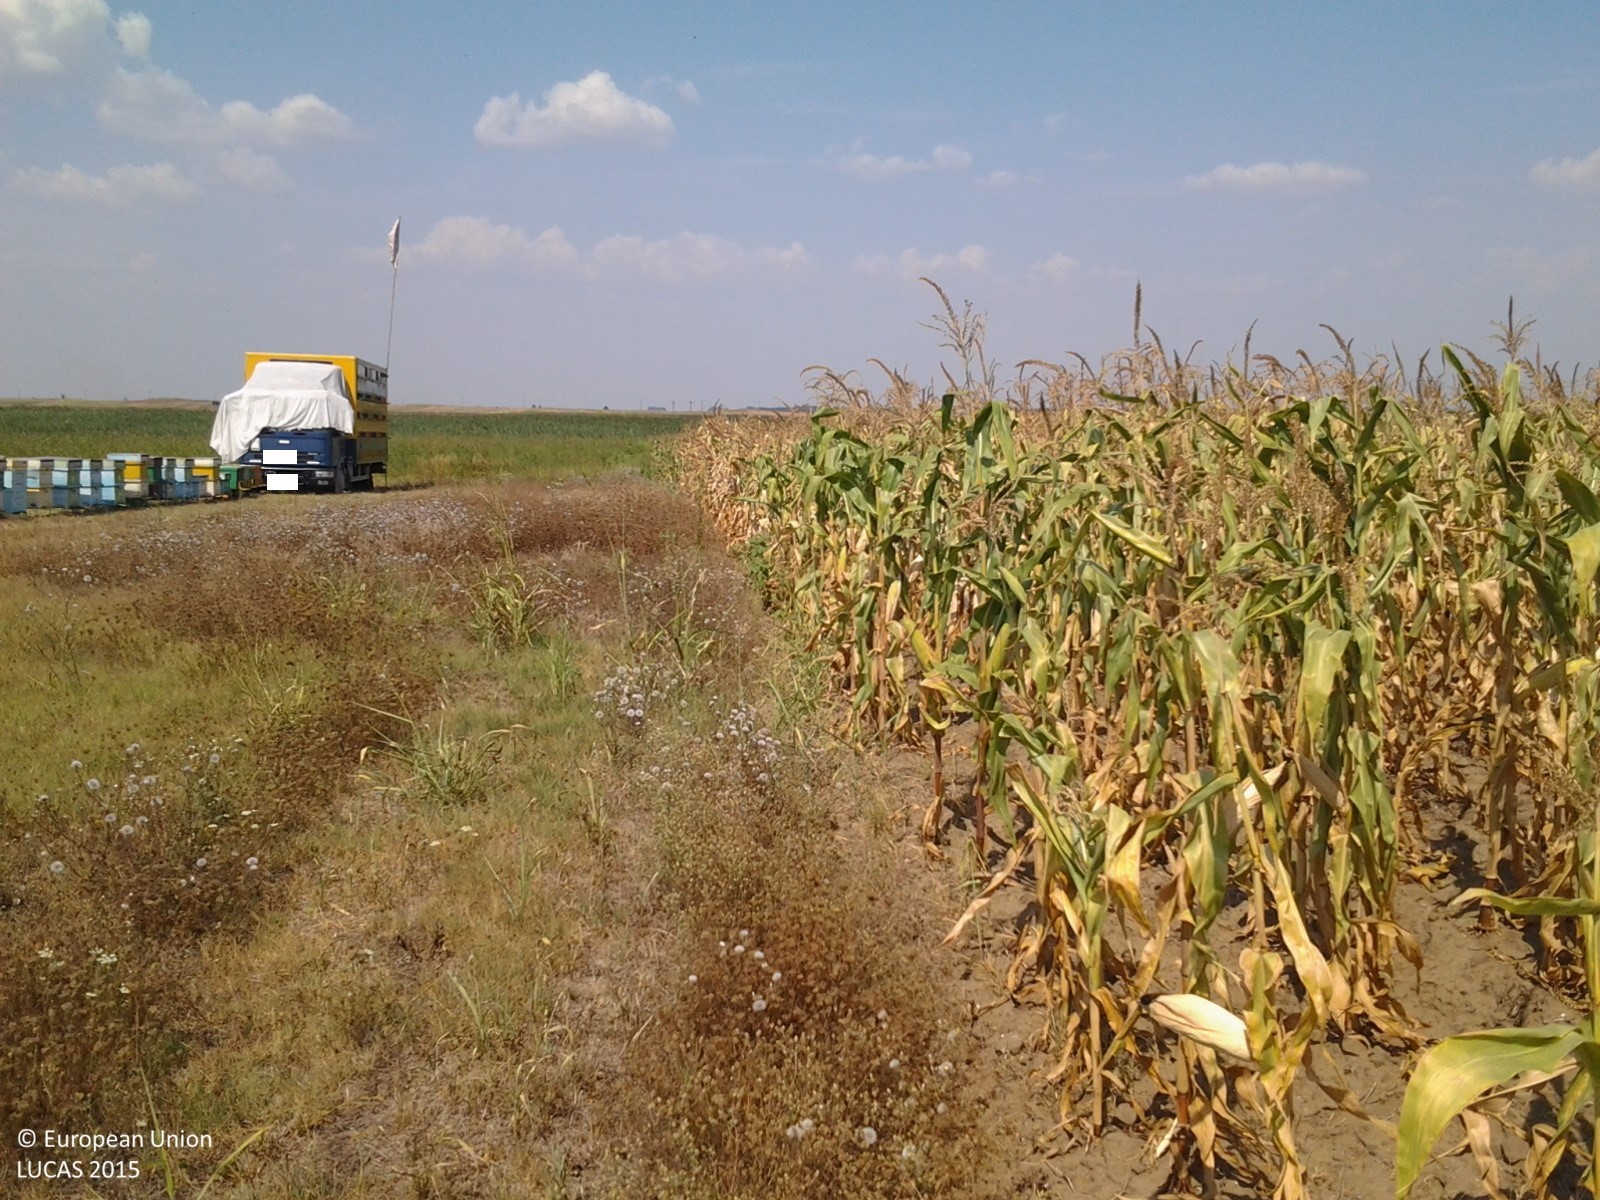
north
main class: Cropland
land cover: Maize
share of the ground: > 75 %
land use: Agriculture (excluding fallow land and kitchen gardens)
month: August
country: RO
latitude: 43.8345
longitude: 23.0366
